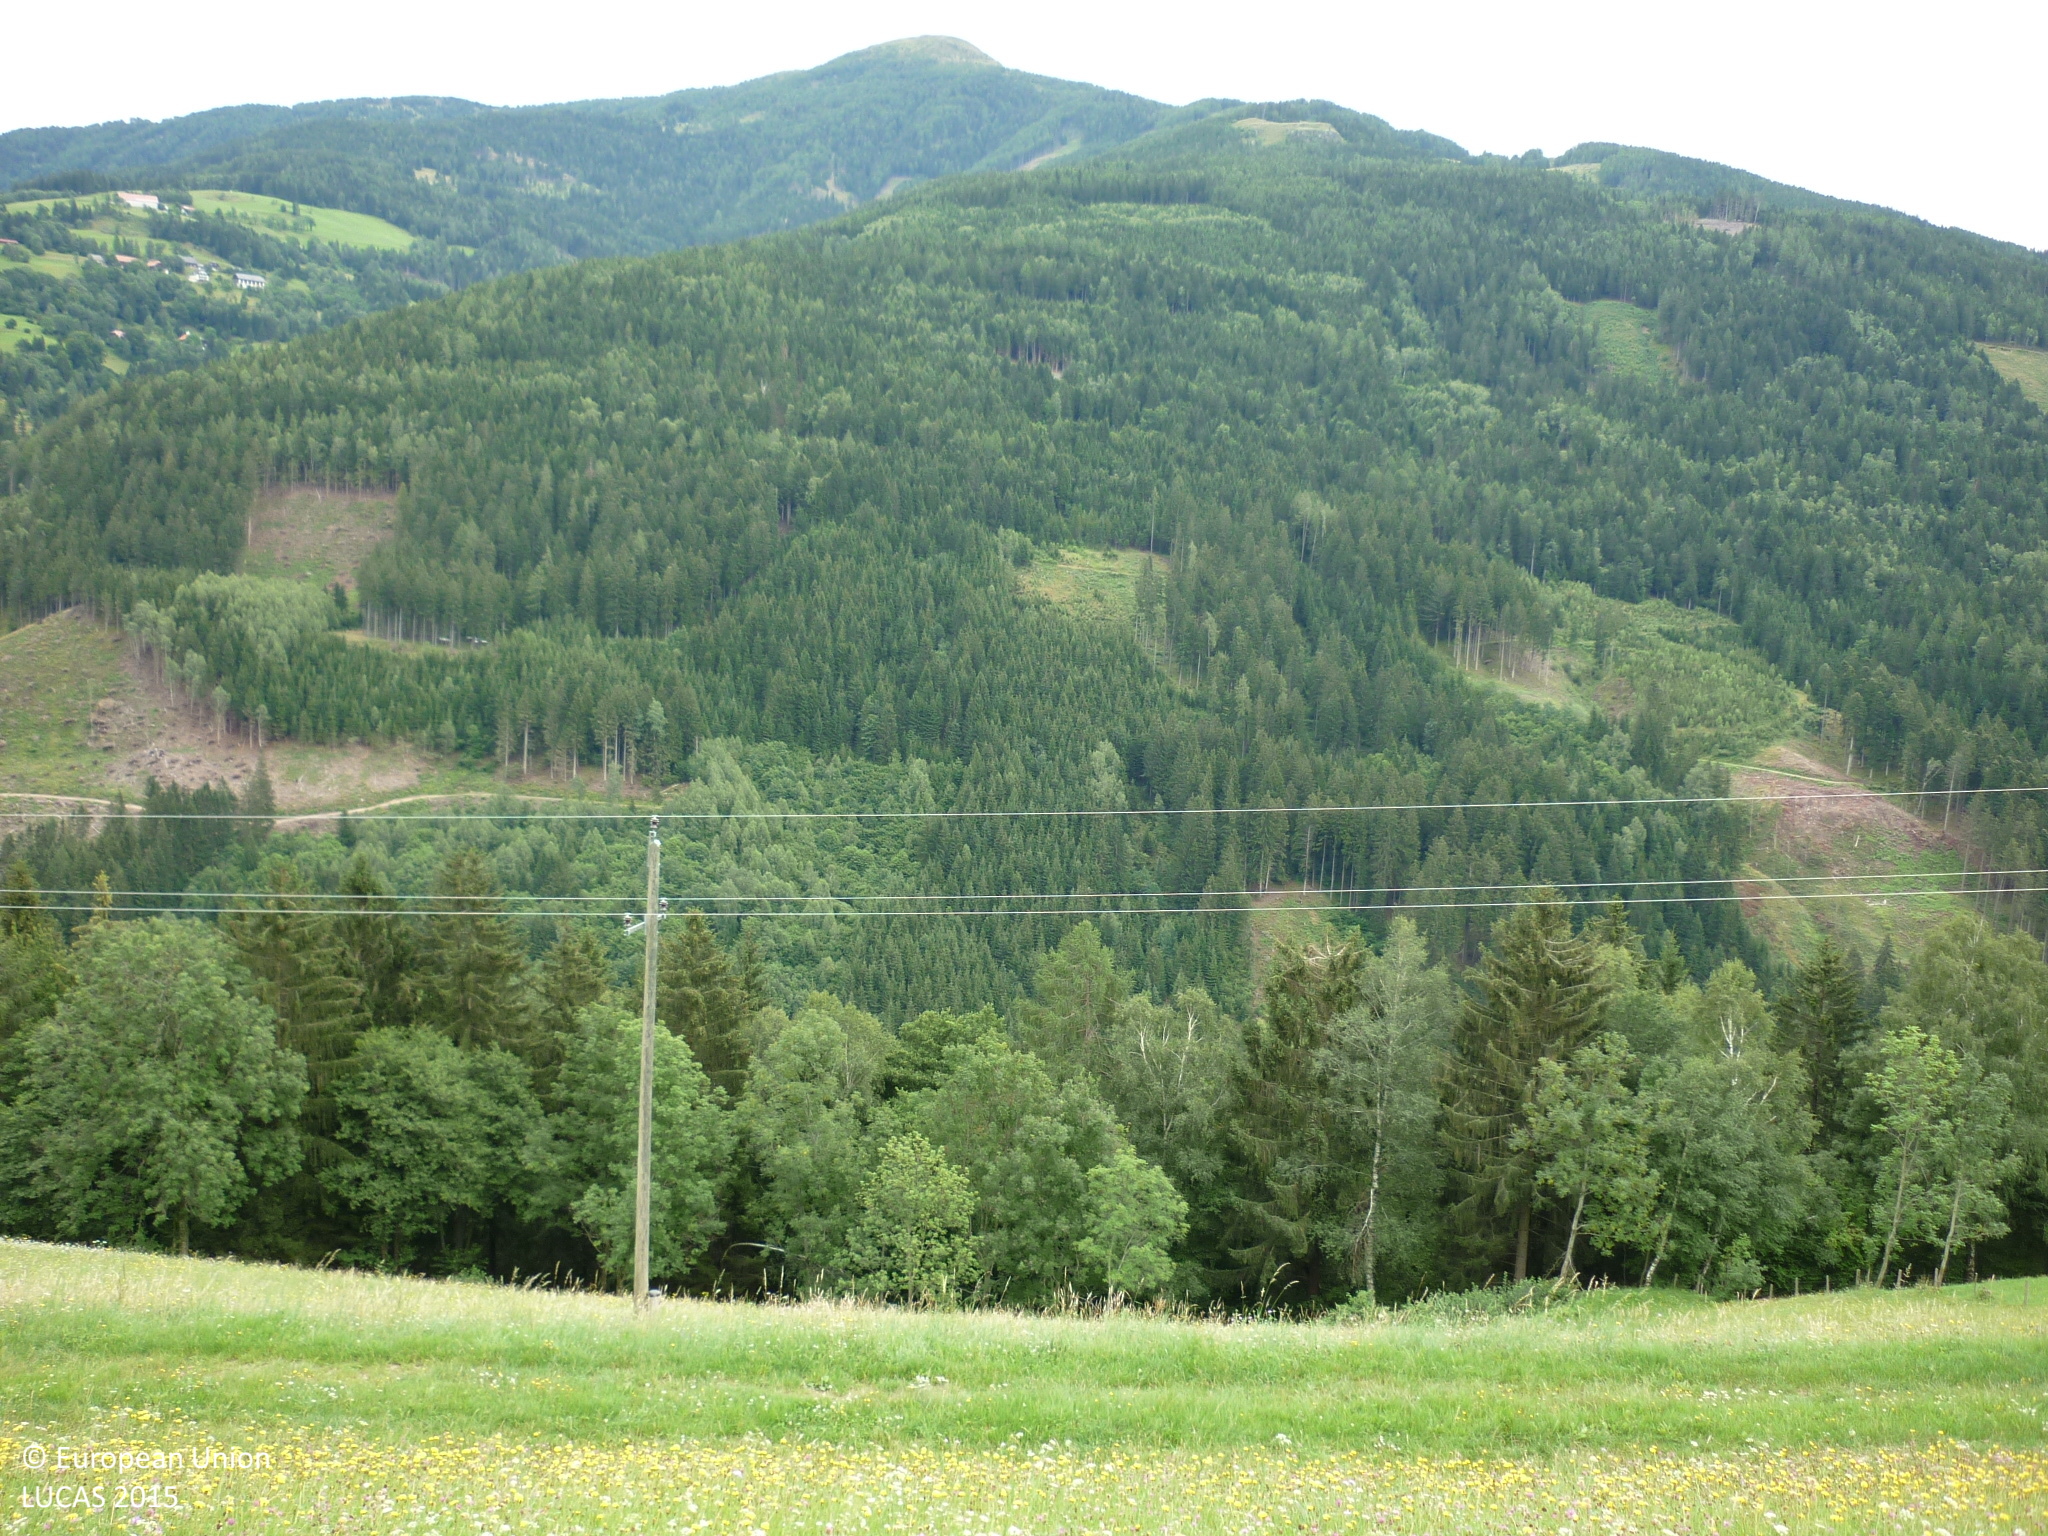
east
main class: Grassland
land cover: Grassland without tree/shrub cover
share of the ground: > 75 %
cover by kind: herbaceous plants 100 %
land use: Agriculture (excluding fallow land and kitchen gardens)
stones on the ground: < 10 %
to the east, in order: Grassland without tree/shrub cover; Tracks; Grassland without tree/shrub cover; Electric lines; Spruce dominated mixed woodland; Fences; Spruce dominated mixed woodland; Rivers and streams; Spruce dominated mixed woodland; Broadleaved woodland; Fences; Paved roads, cycling and walking lanes; Broadleaved woodland; Grass margins; Tracks; Grass margins; Broadleaved woodland
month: August
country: AT
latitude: 46.8708
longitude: 13.5005
